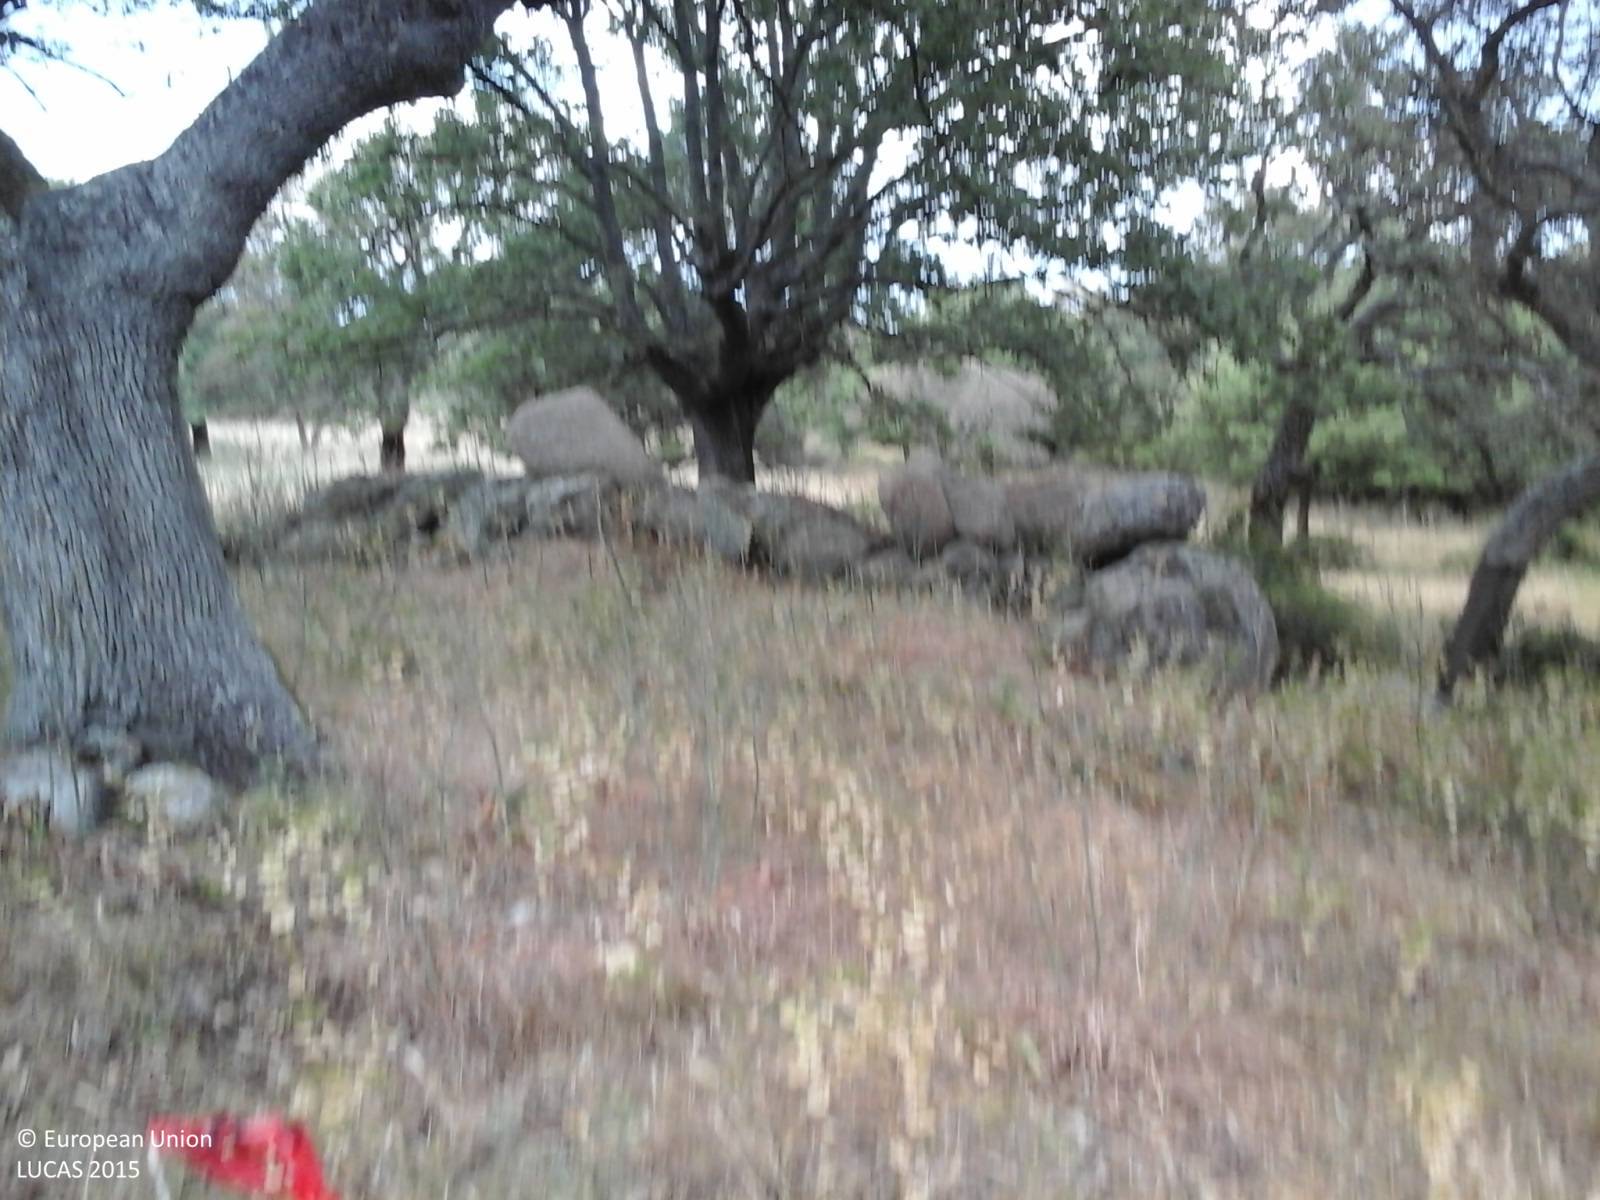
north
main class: Woodland
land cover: Broadleaved woodland
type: broadleaved evergreen forest
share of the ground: > 75 %
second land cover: Grassland without tree/shrub cover
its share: > 75 %
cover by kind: broadleaved forest trees 80 %, herbaceous plants 20 %
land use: Forestry
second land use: Agriculture (excluding fallow land and kitchen gardens)
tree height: > 5 m
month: June
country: IT
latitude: 40.4991
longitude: 9.1664
